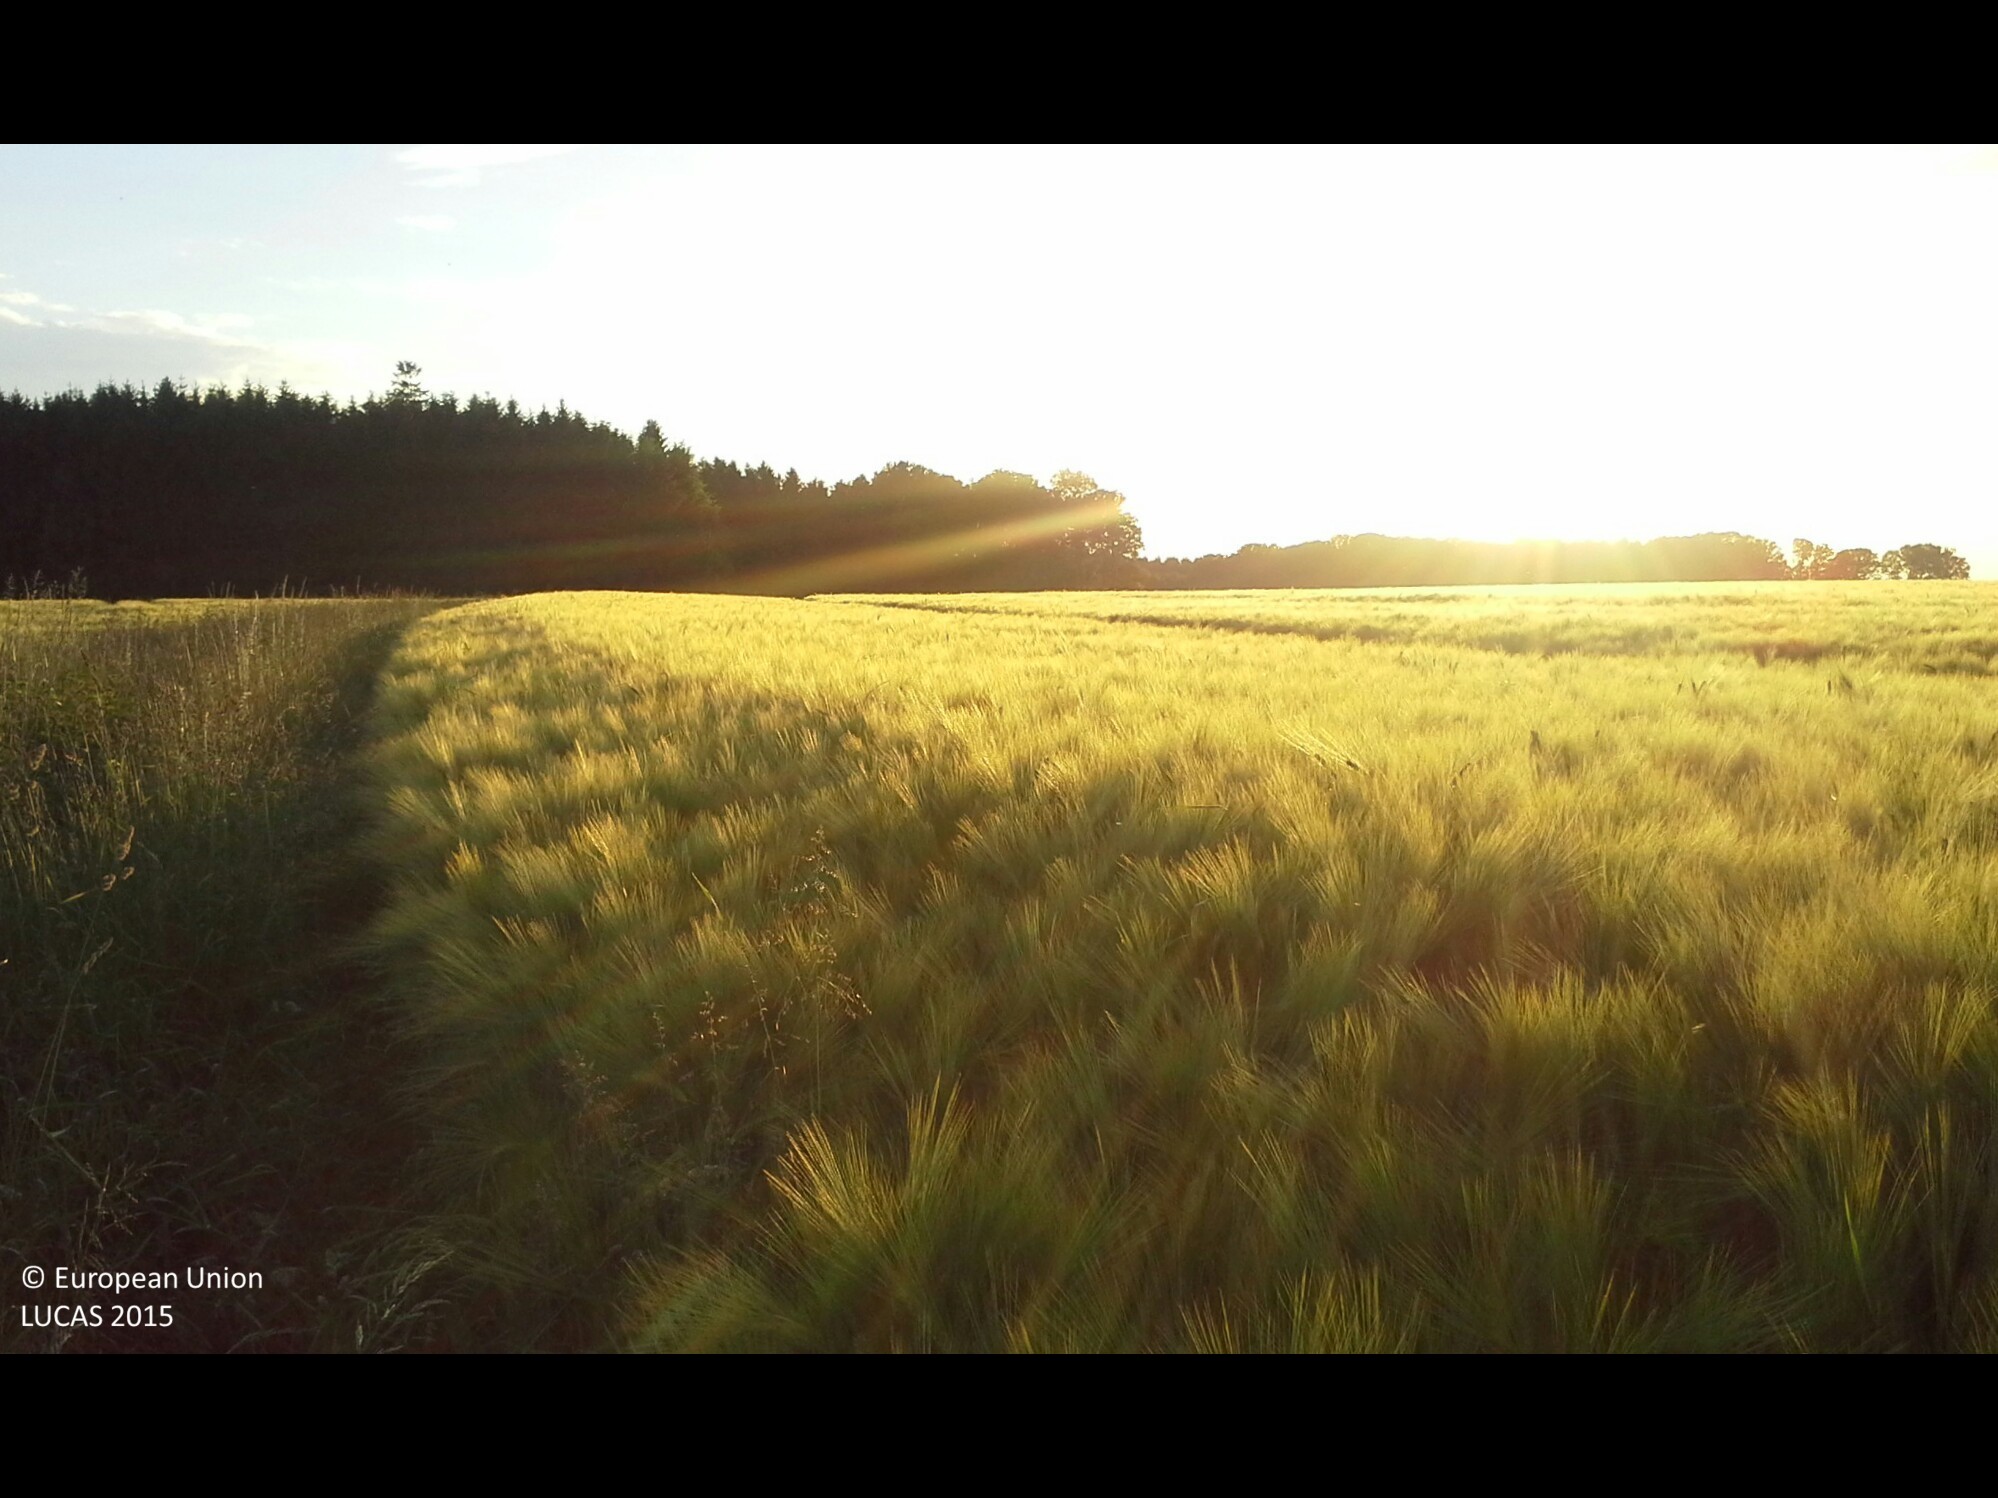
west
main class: Cropland
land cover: Barley
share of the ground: > 75 %
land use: Agriculture (excluding fallow land and kitchen gardens)
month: May
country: AT
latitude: 48.1392
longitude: 14.3138
